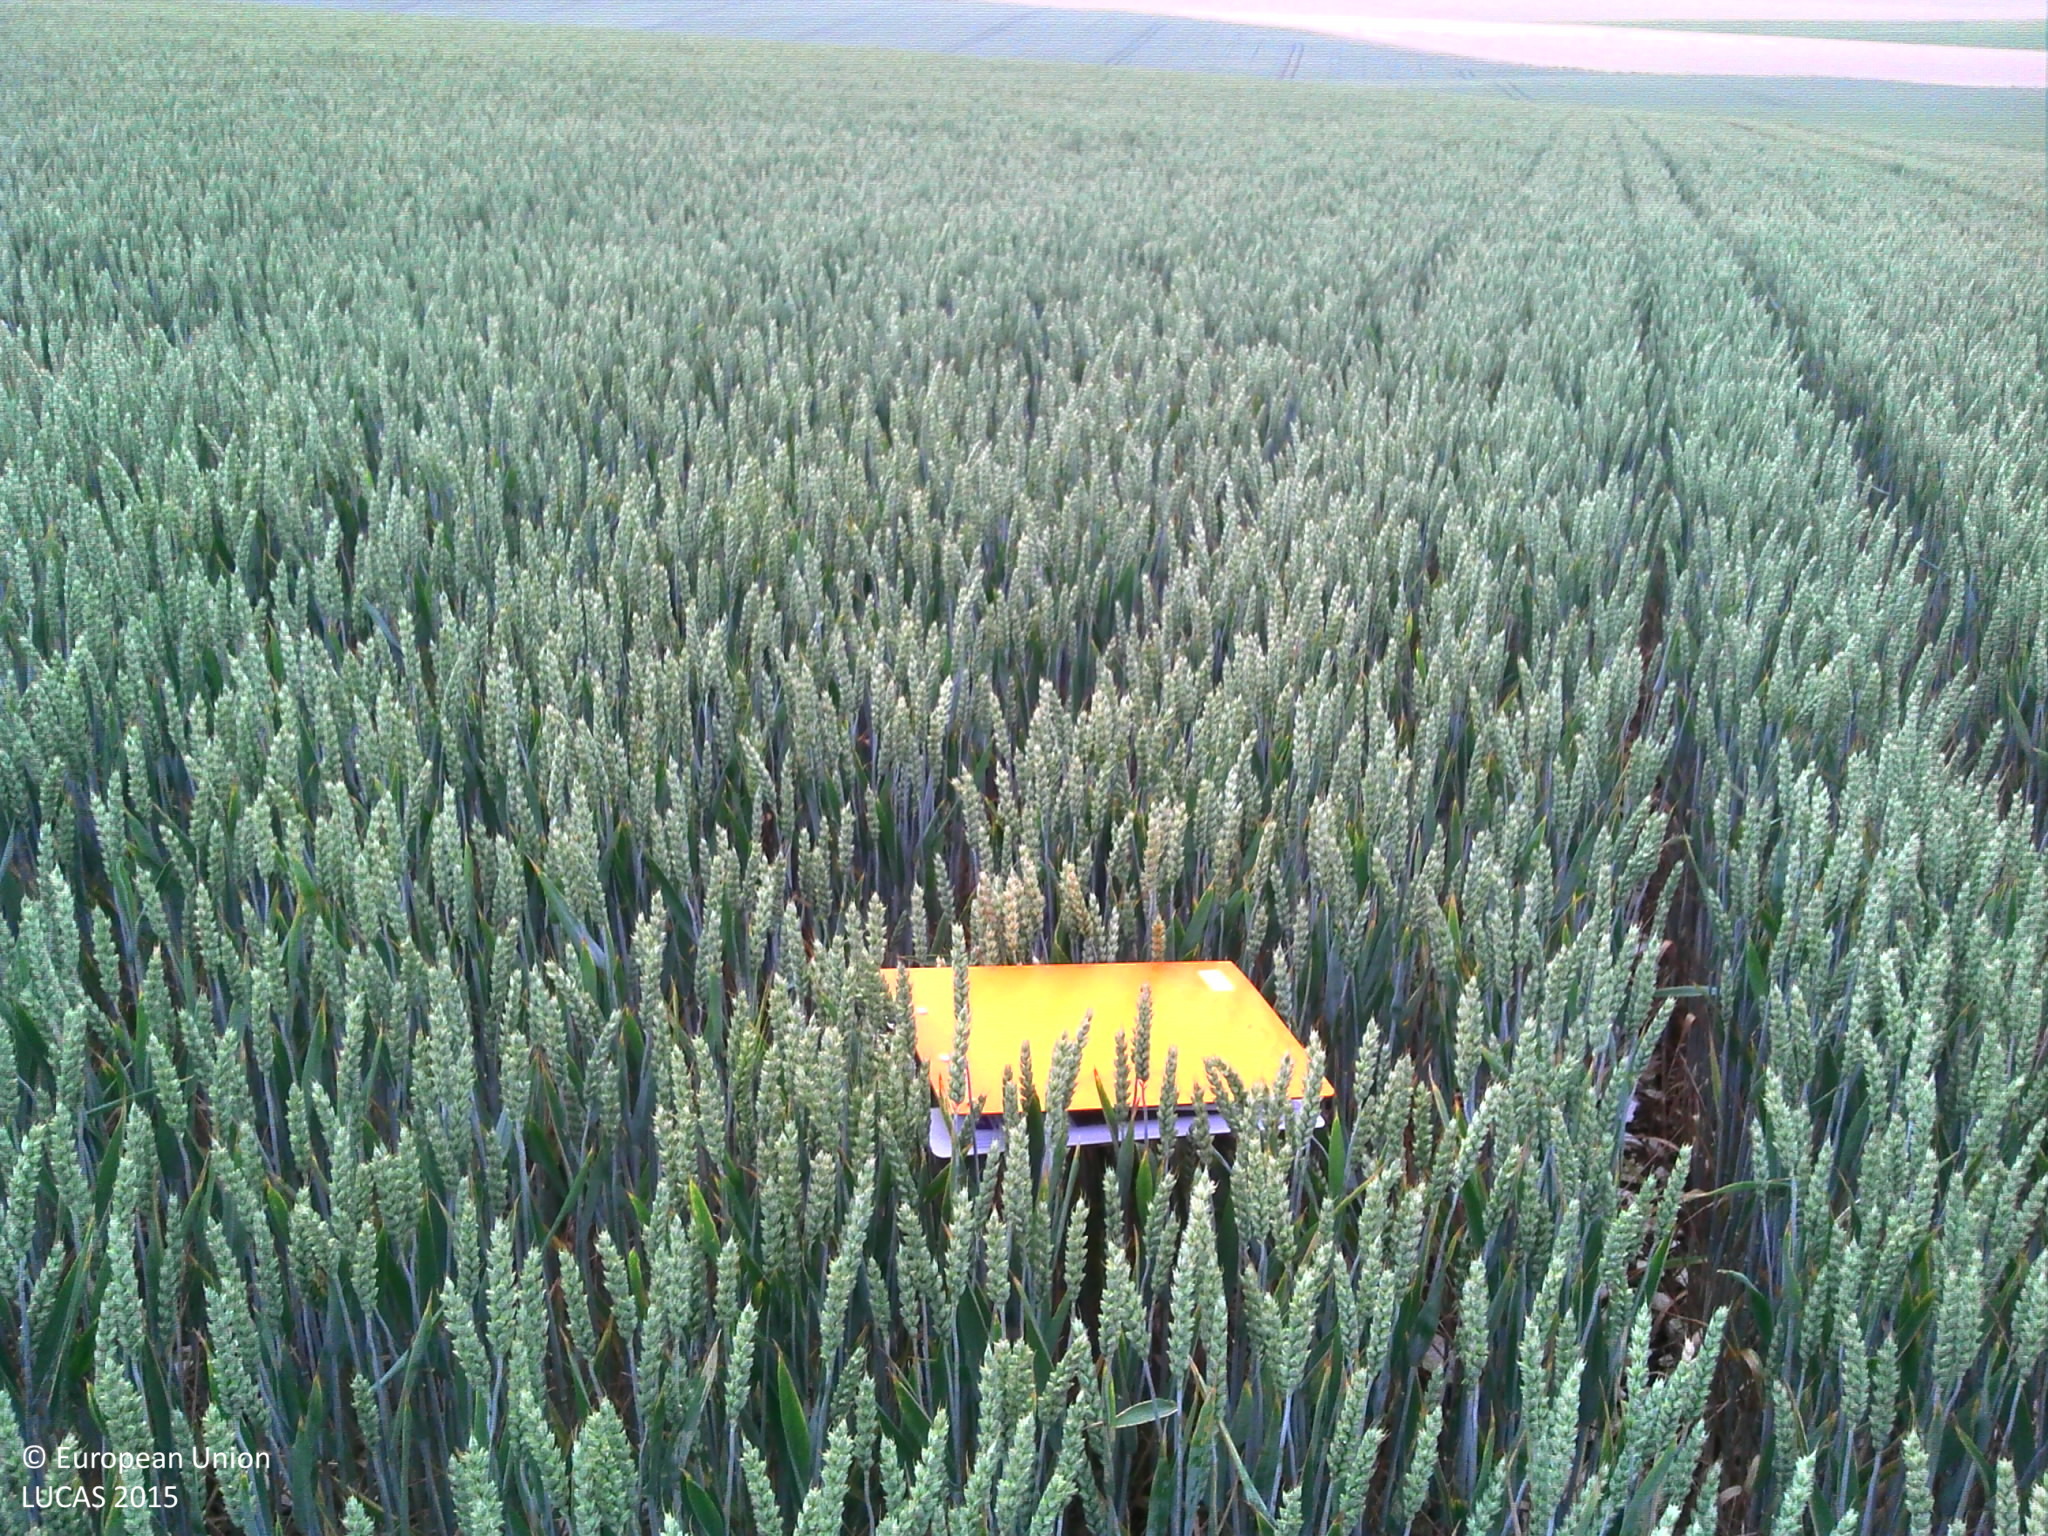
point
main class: Cropland
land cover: Common wheat
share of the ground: > 75 %
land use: Agriculture (excluding fallow land and kitchen gardens)
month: June
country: FR
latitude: 48.1982
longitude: 4.9535
